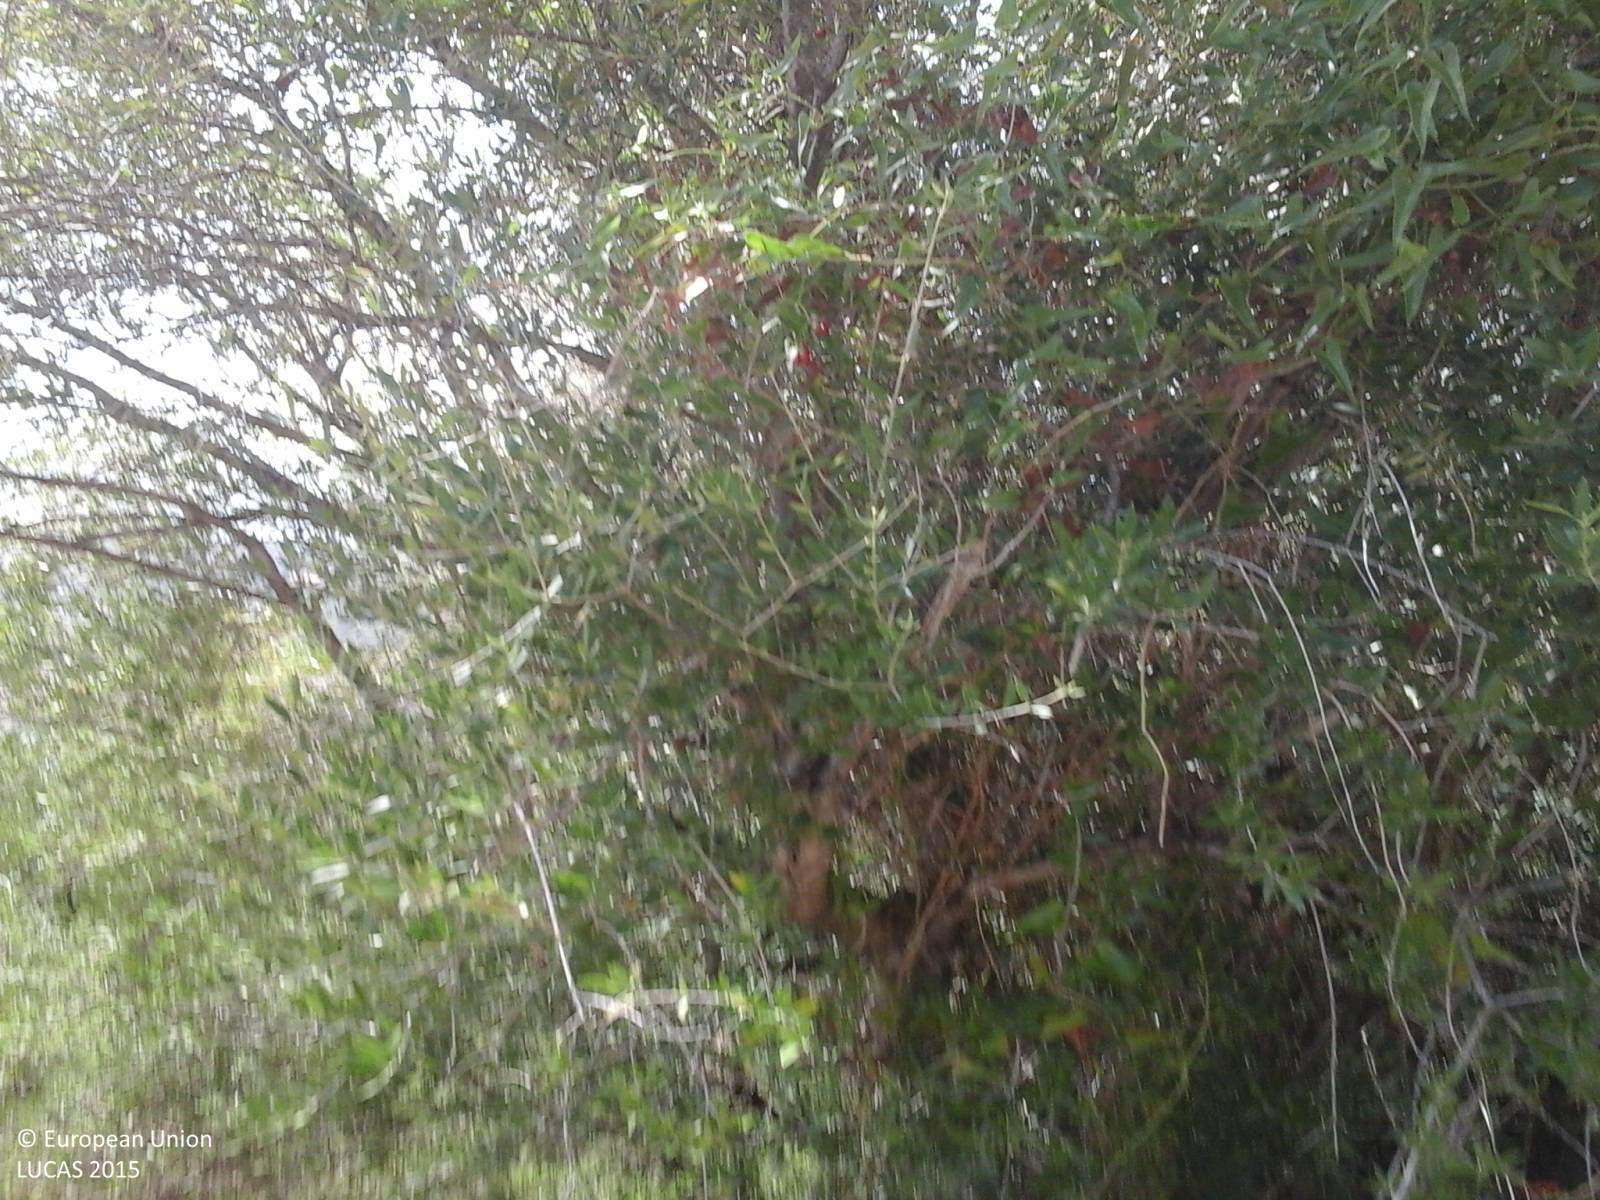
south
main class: Woodland
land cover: Broadleaved woodland
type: broadleaved evergreen forest
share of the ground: > 75 %
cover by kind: broadleaved forest trees 50 %, shrubs 20 %, unconsolidated bare surface 20 %, herbaceous plants 10 %
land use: Semi-natural and natural areas not in use
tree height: > 5 m
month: September
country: IT
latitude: 39.9952
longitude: 9.6855
